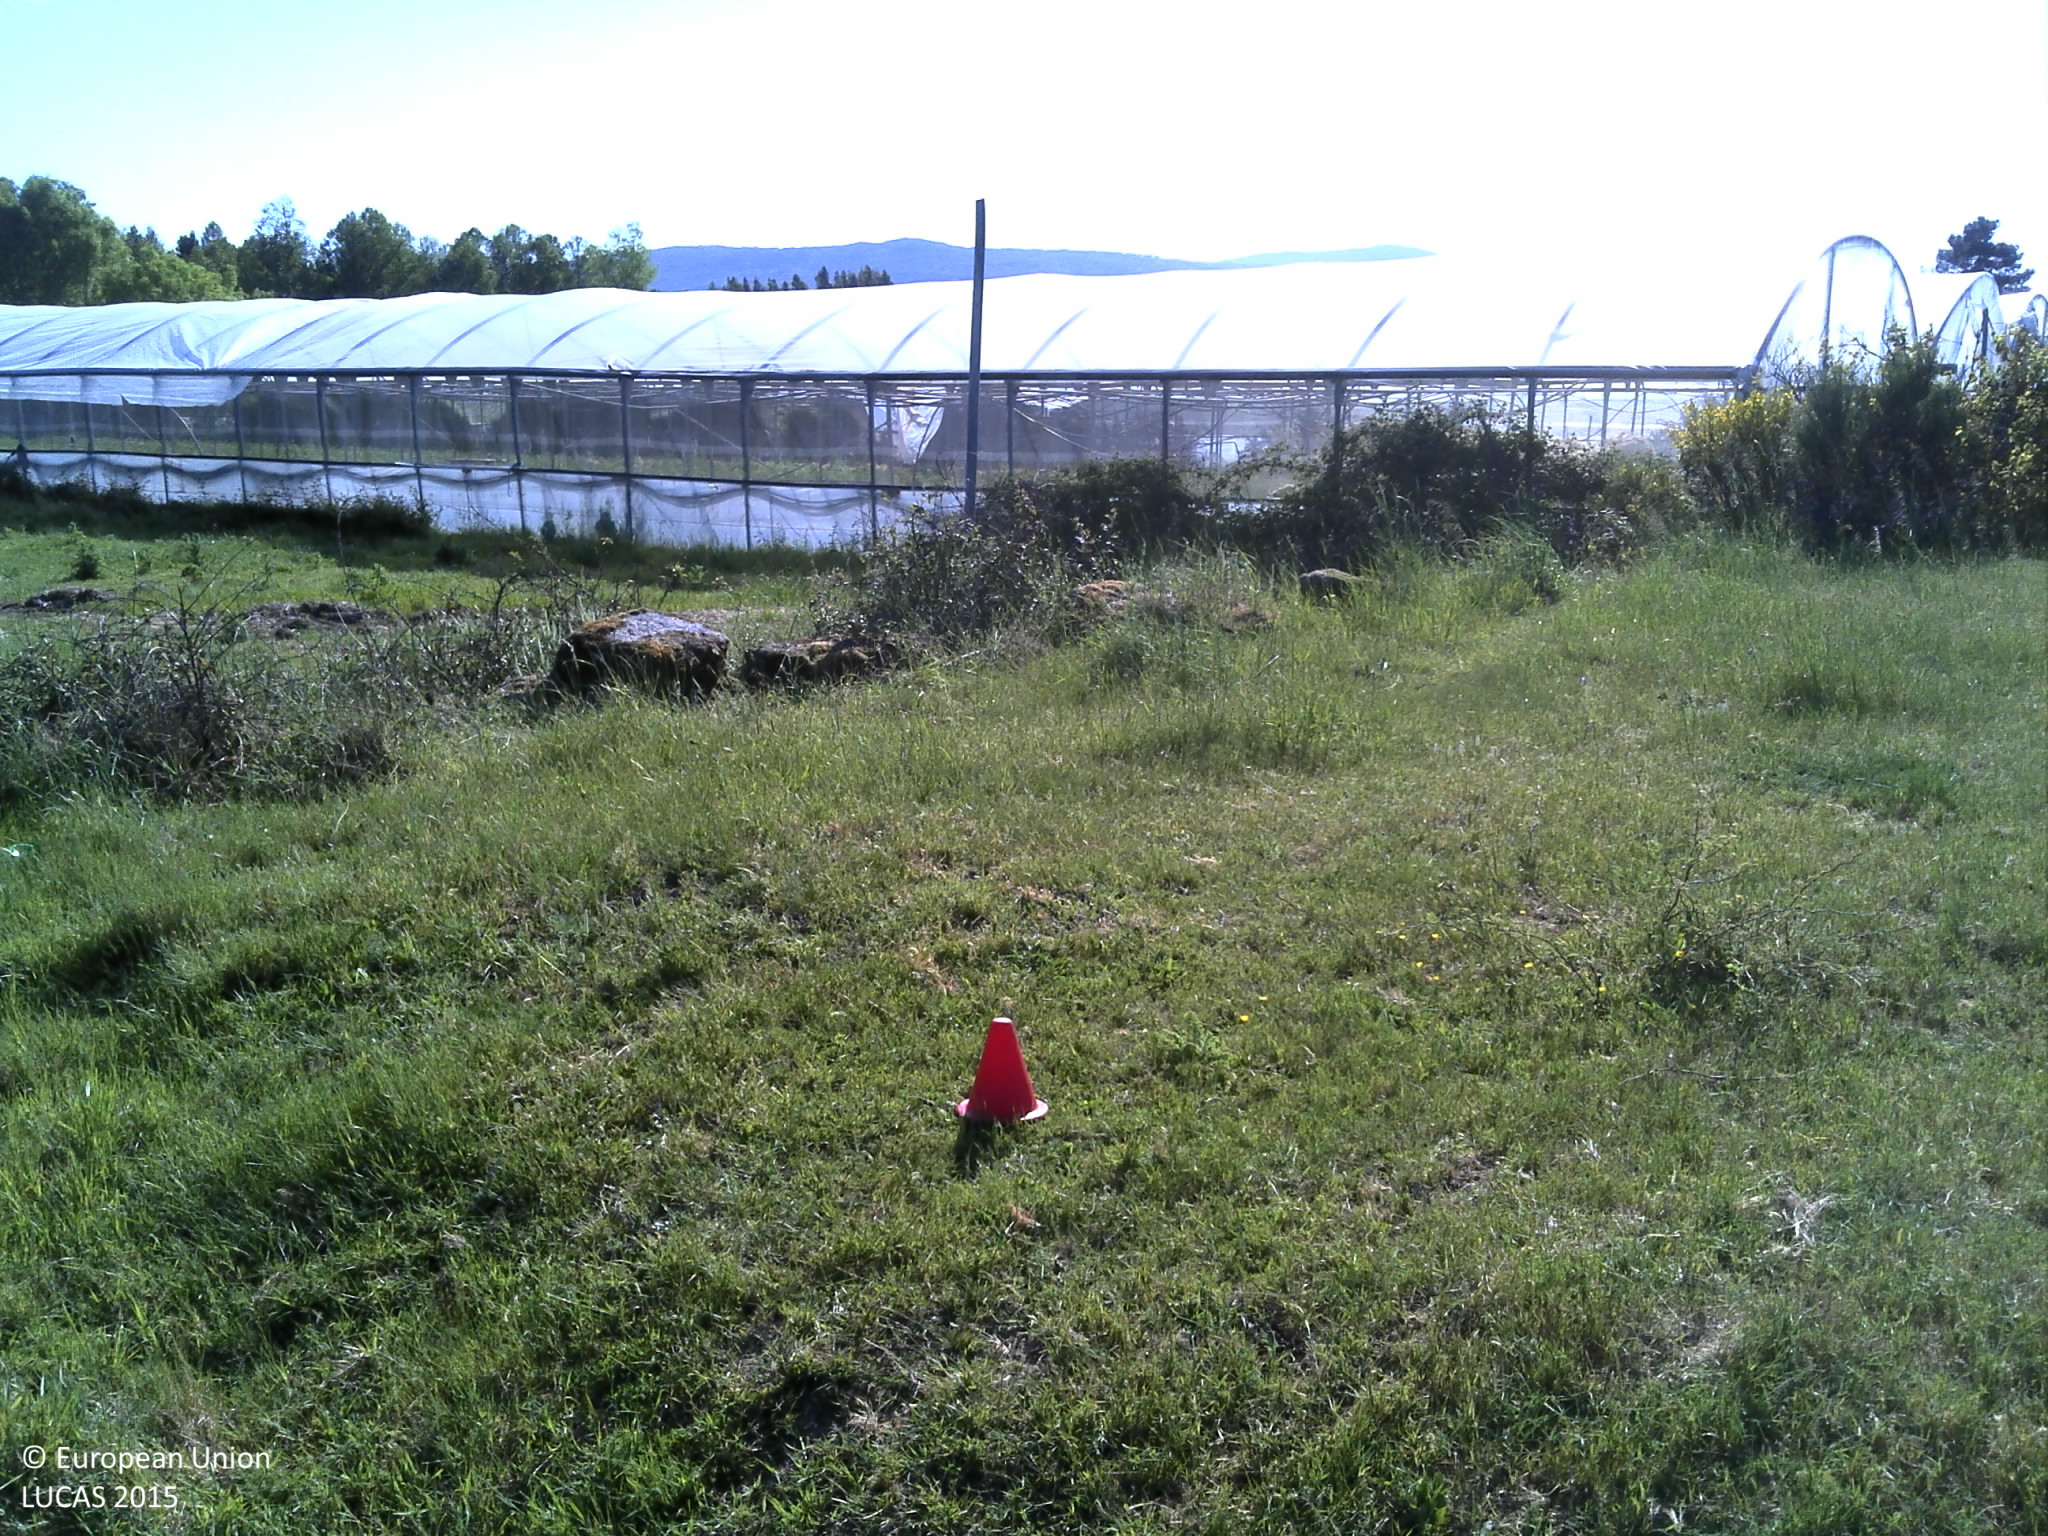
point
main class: Grassland
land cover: Grassland without tree/shrub cover
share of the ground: > 75 %
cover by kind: herbaceous plants 80 %, unconsolidated bare surface 15 %, shrubs 5 %
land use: Agriculture (excluding fallow land and kitchen gardens)
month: May
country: PT
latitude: 41.5636
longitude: -7.5775
